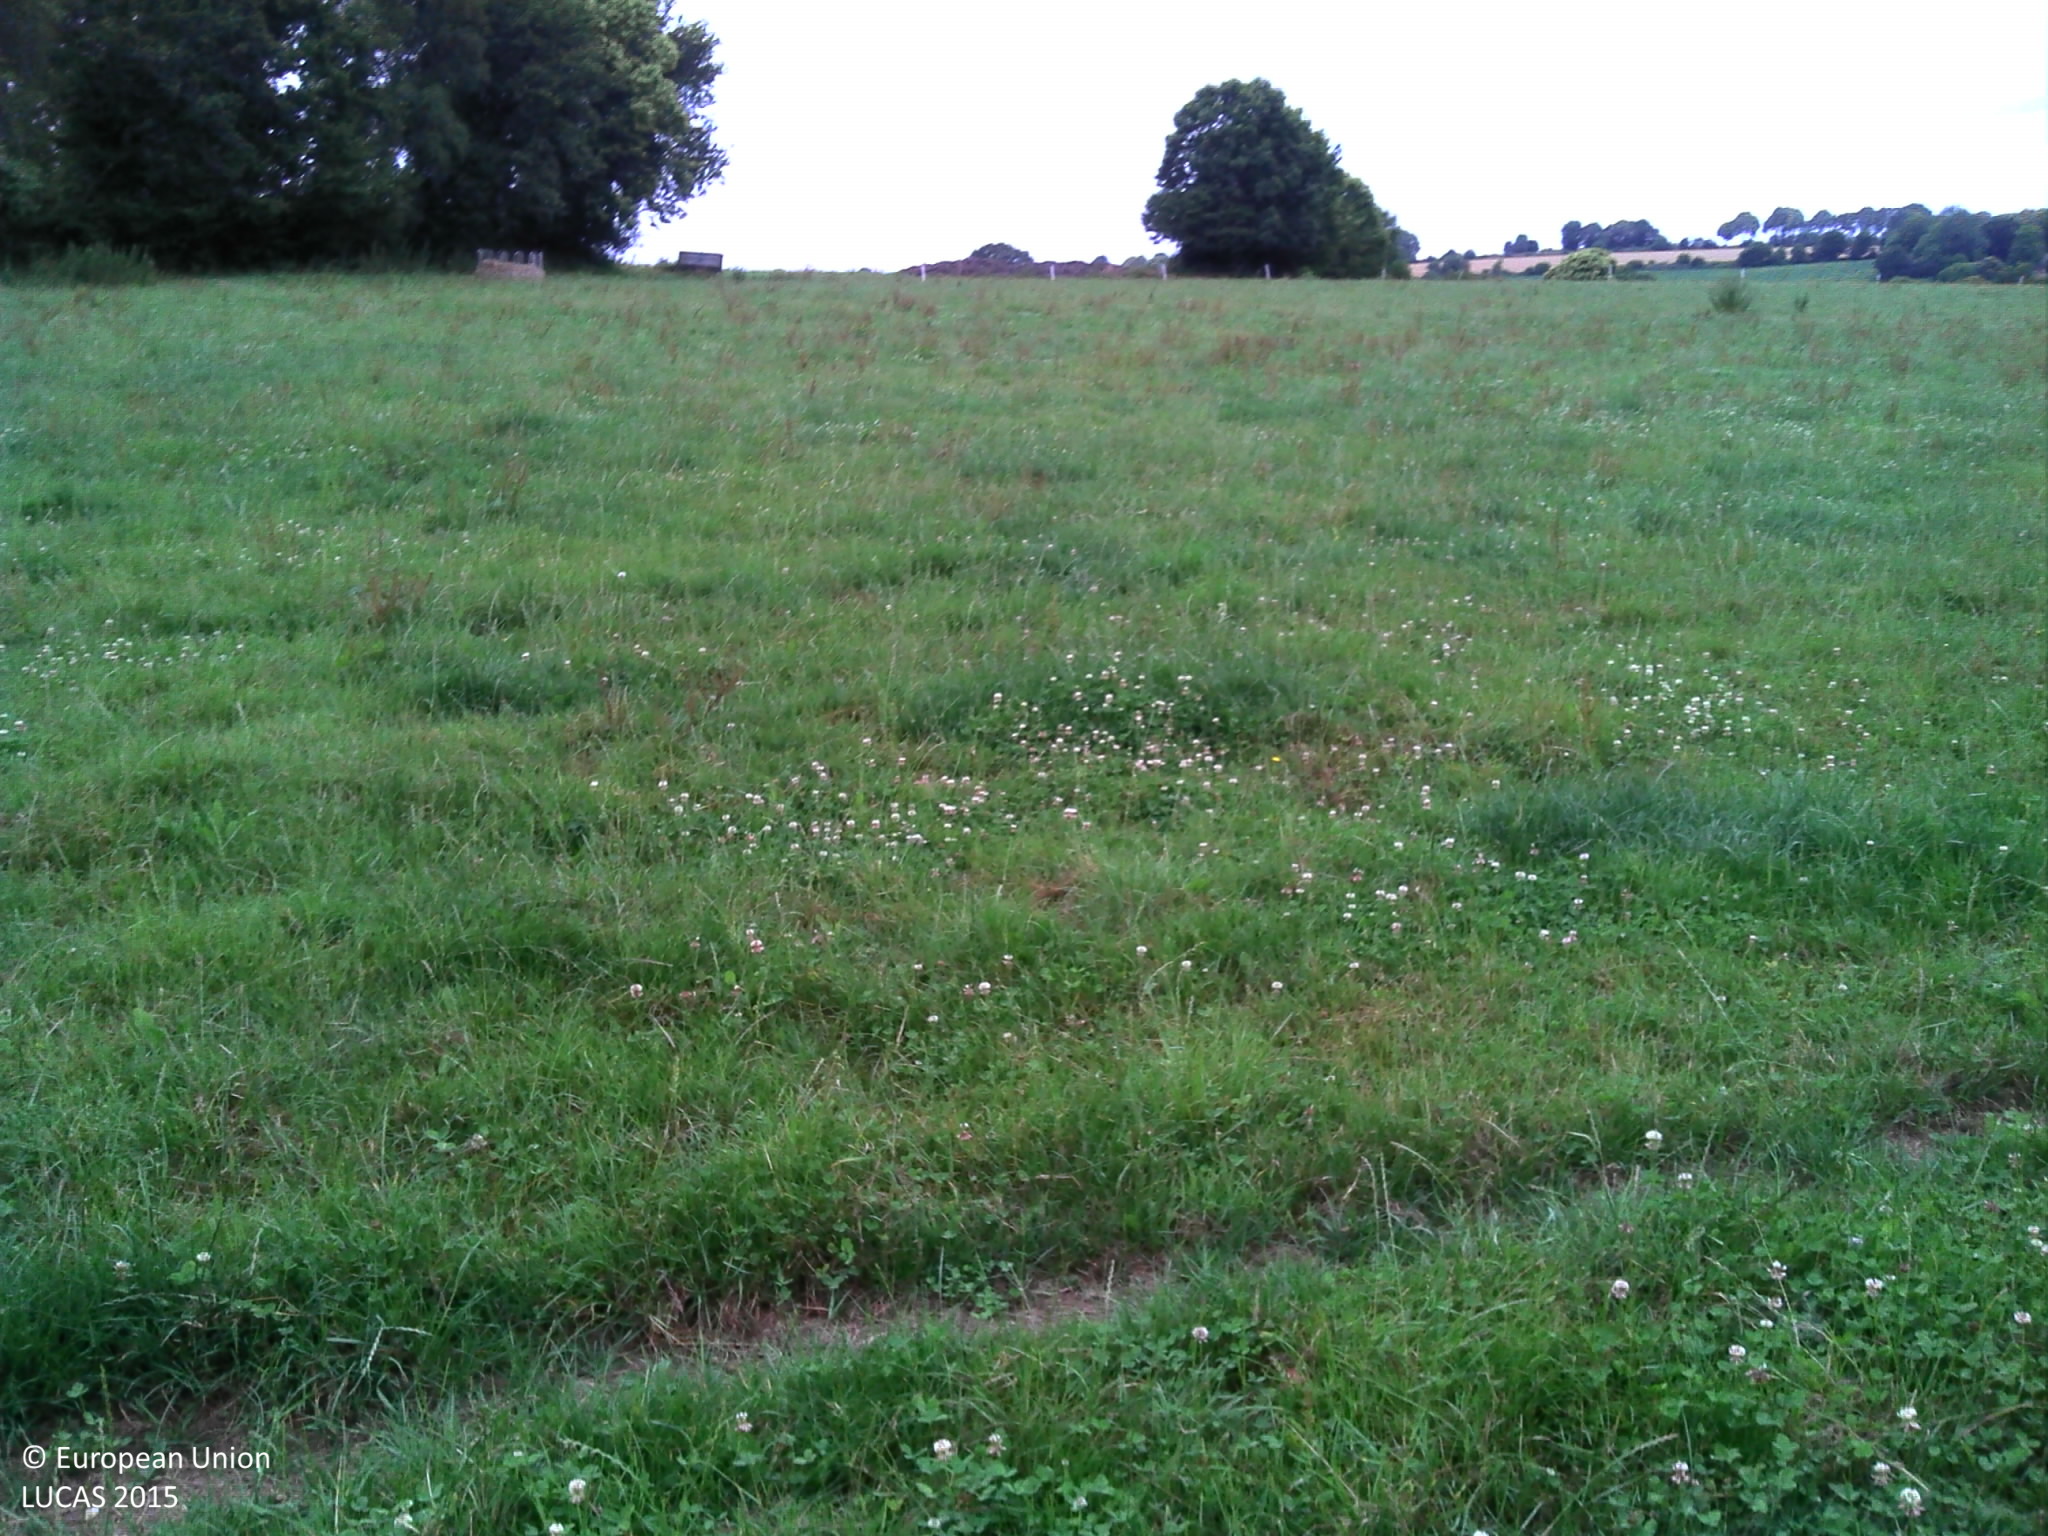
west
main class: Grassland
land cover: Grassland without tree/shrub cover
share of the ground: > 75 %
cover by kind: herbaceous plants 100 %
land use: Agriculture (excluding fallow land and kitchen gardens)
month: July
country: FR
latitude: 48.1196
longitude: -3.6343
